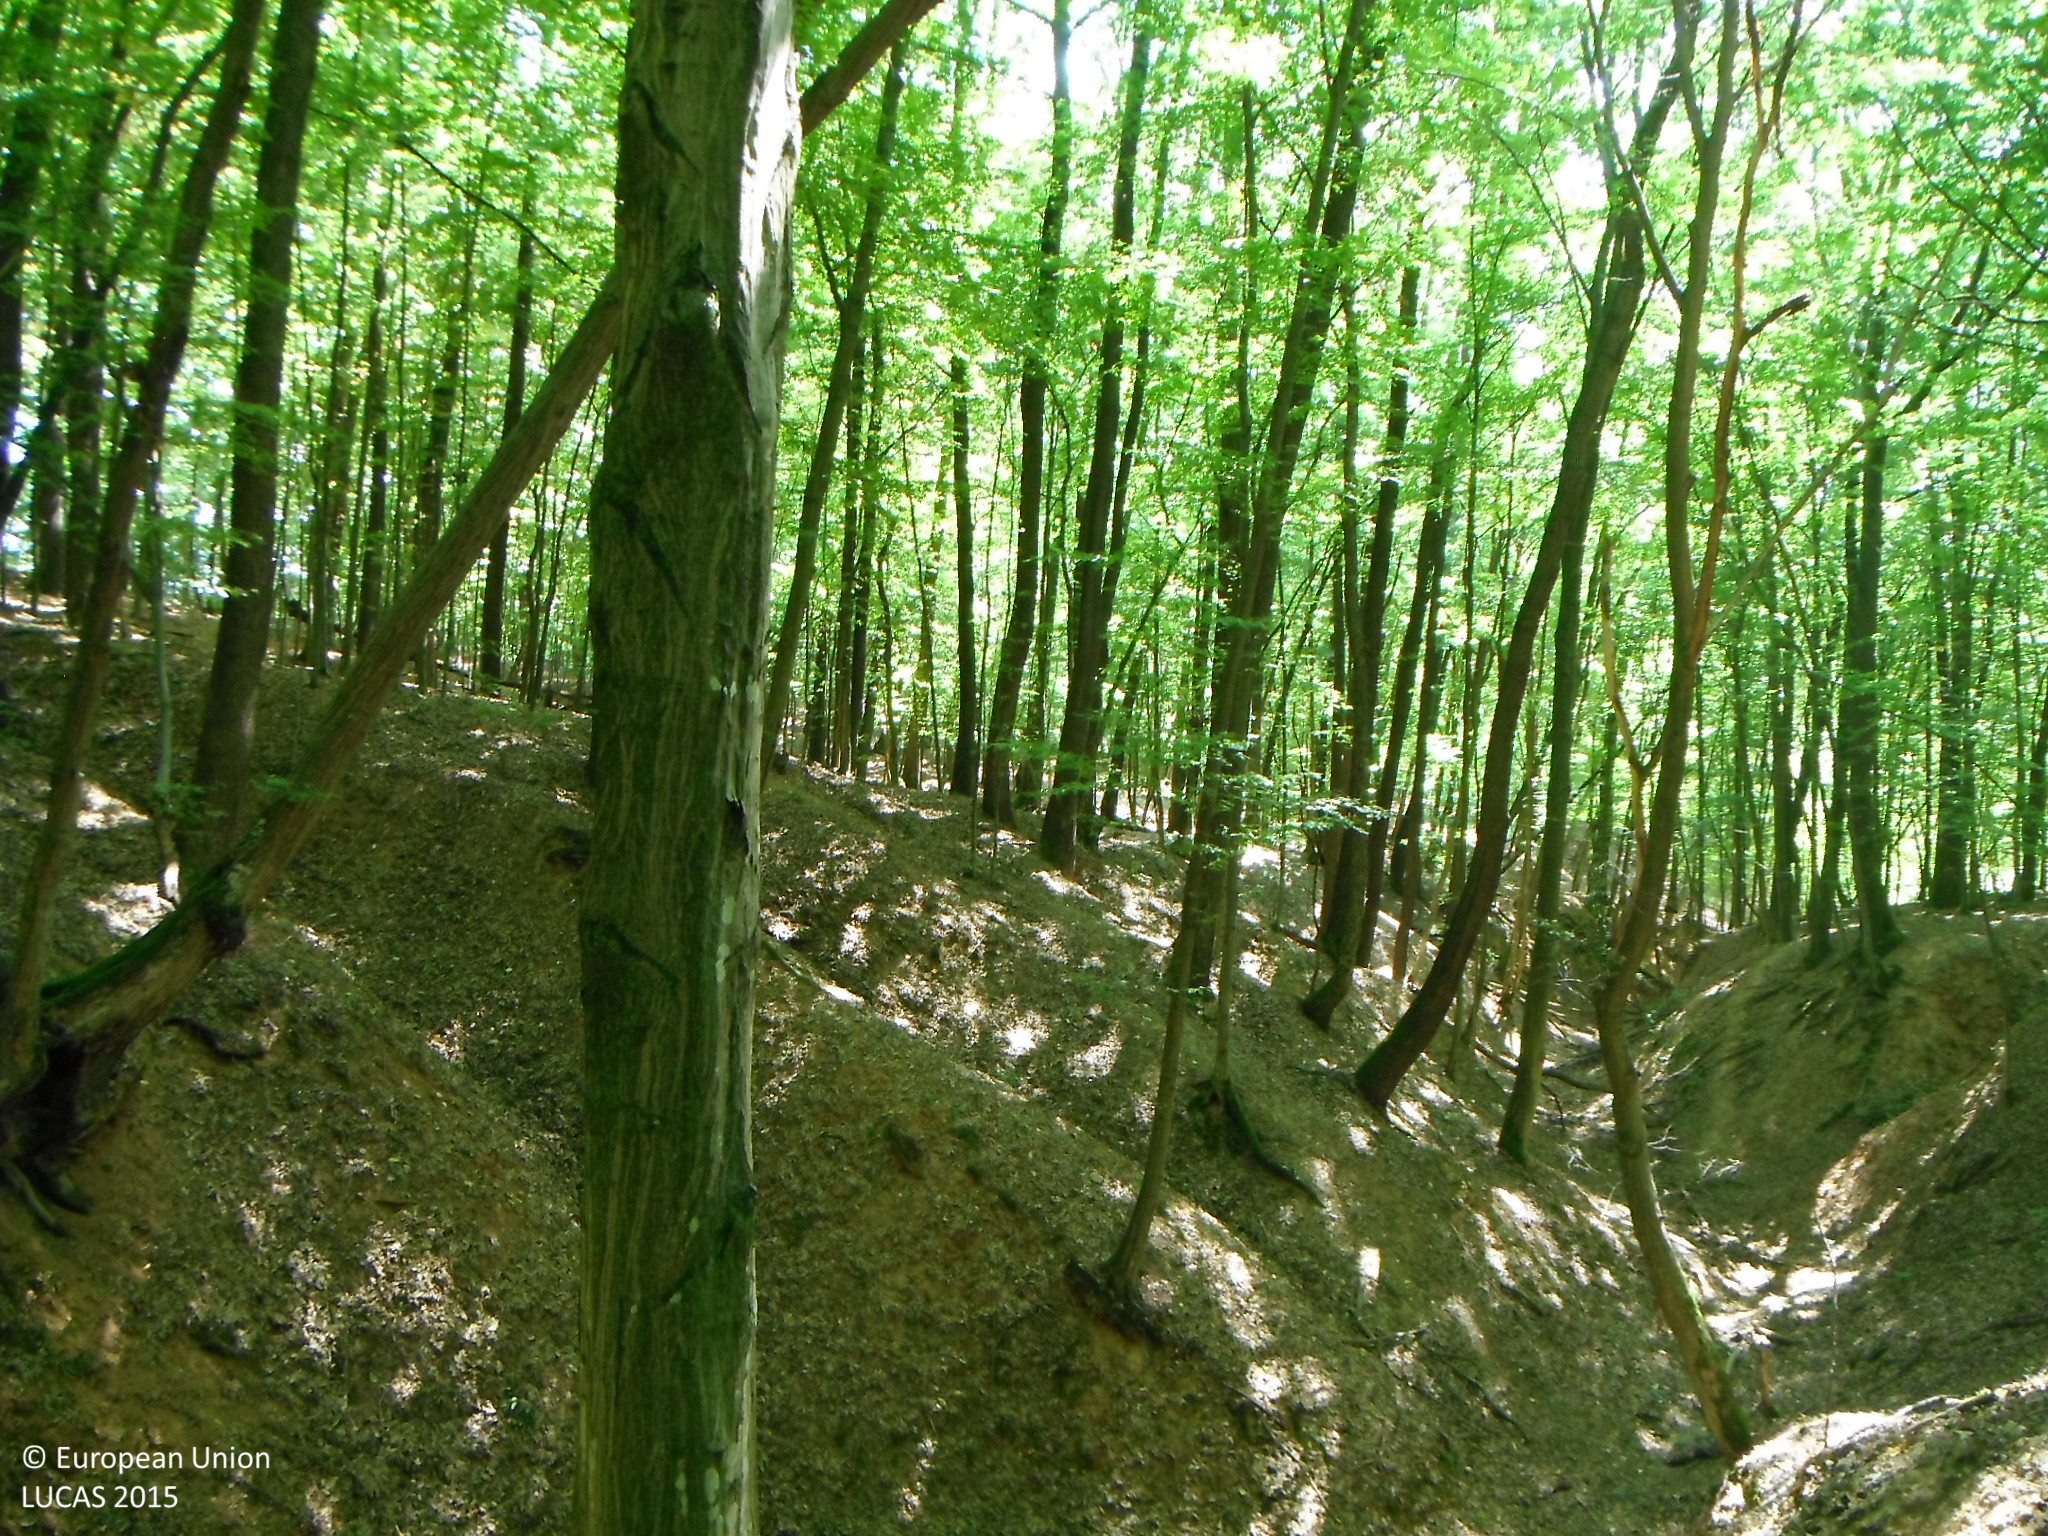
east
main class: Woodland
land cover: Broadleaved woodland
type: mesophytic deciduous forest
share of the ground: > 75 %
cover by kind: broadleaved forest trees 100 %
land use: Forestry
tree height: > 5 m
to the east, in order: Broadleaved woodland
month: July
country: SK
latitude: 48.2484
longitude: 19.0569
